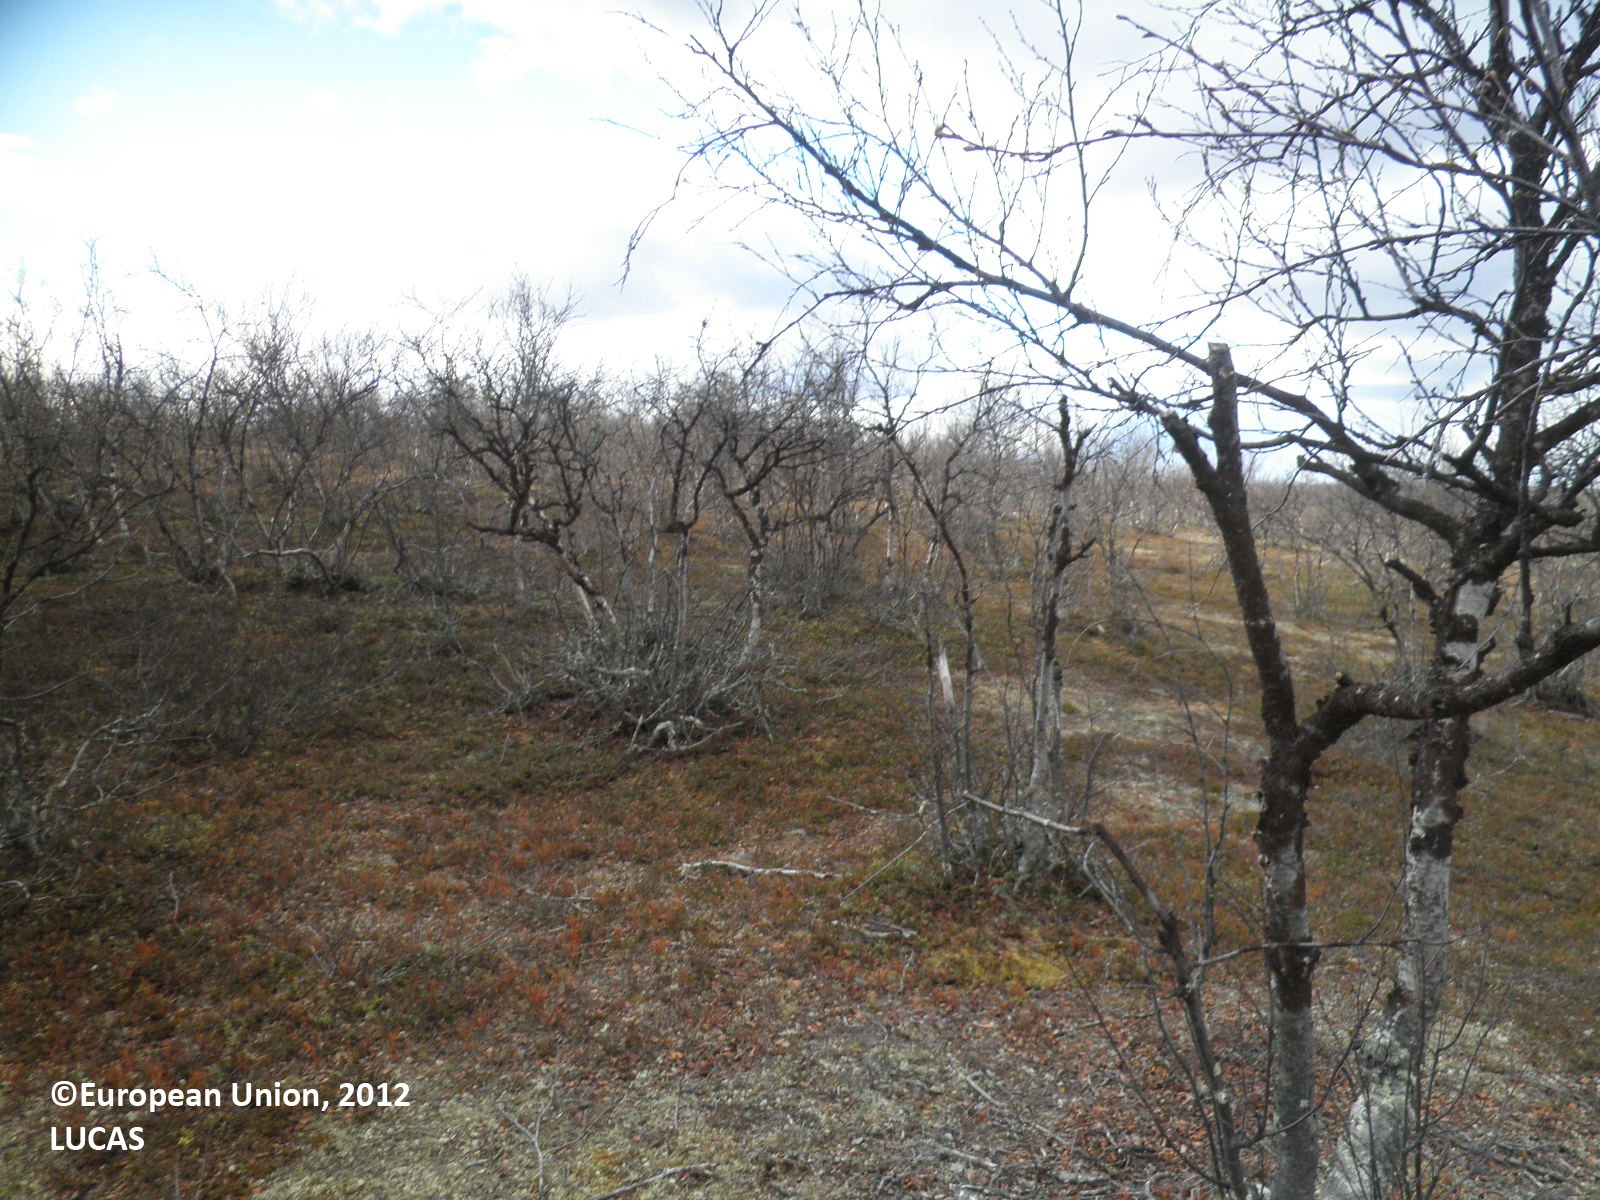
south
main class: Woodland
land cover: Broadleaved woodland
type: boreal forest
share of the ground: 10 - 25 %
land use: Semi-natural and natural areas not in use
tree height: > 5 m
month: May
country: FI
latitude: 69.4700
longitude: 27.2504
